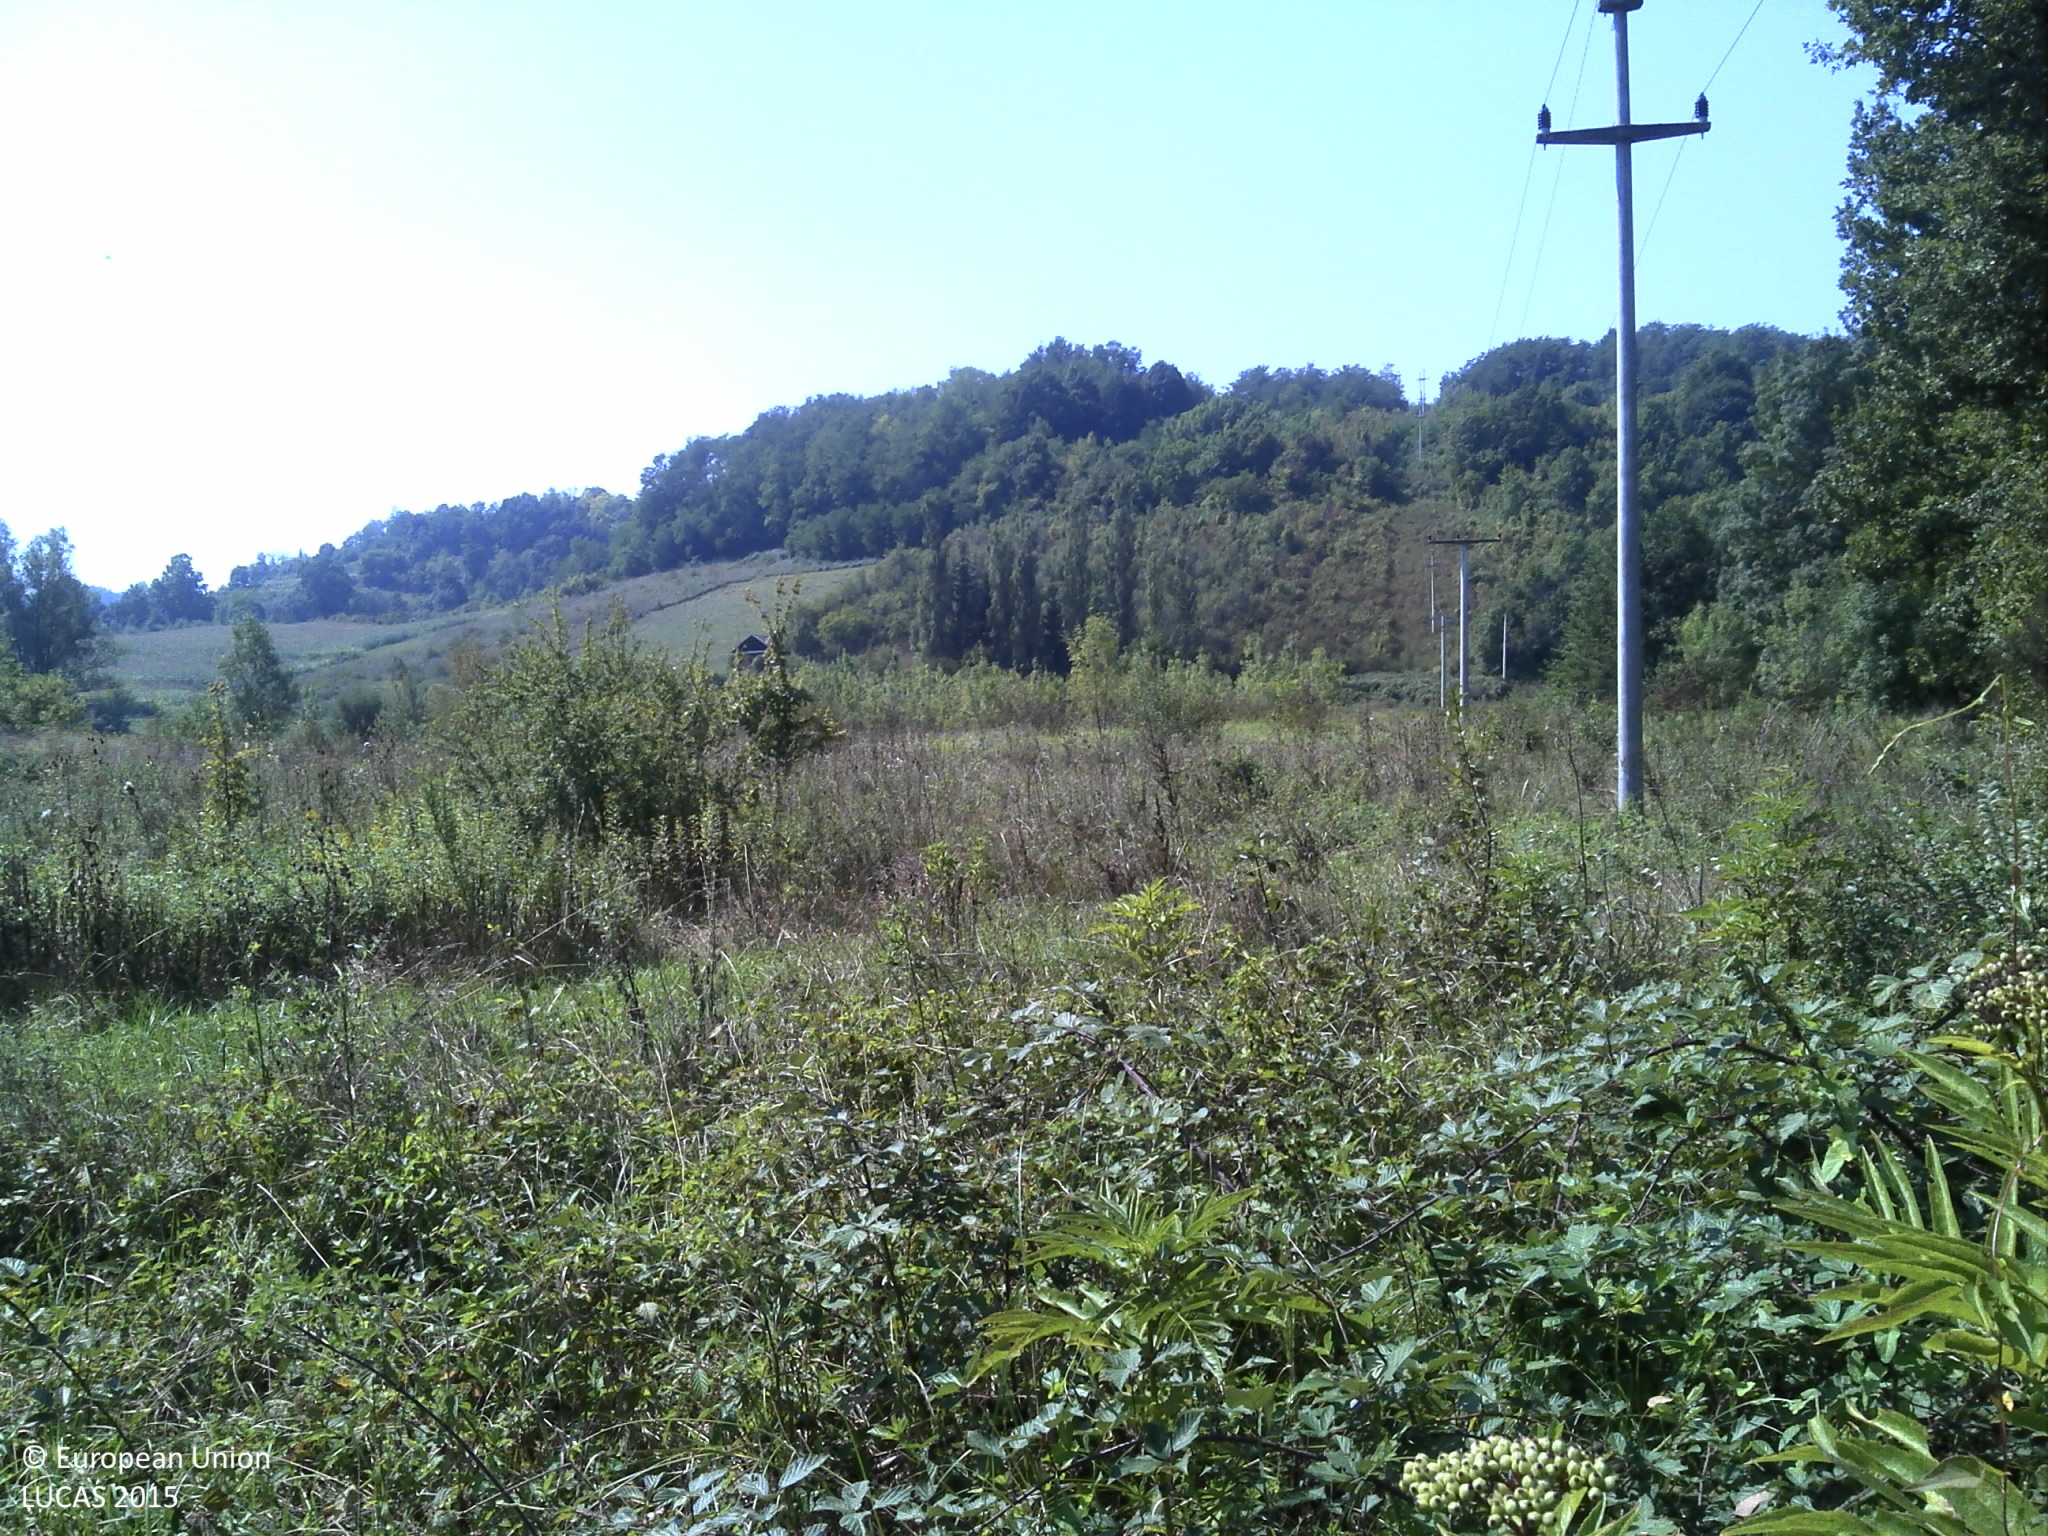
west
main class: Shrubland
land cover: Shrubland with sparse tree cover
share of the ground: > 75 %
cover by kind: shrubs 90 %, broadleaved forest trees 5 %, herbaceous plants 5 %
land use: Semi-natural and natural areas not in use
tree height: < 5 m
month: August
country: HR
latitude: 45.3171
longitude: 16.2860
